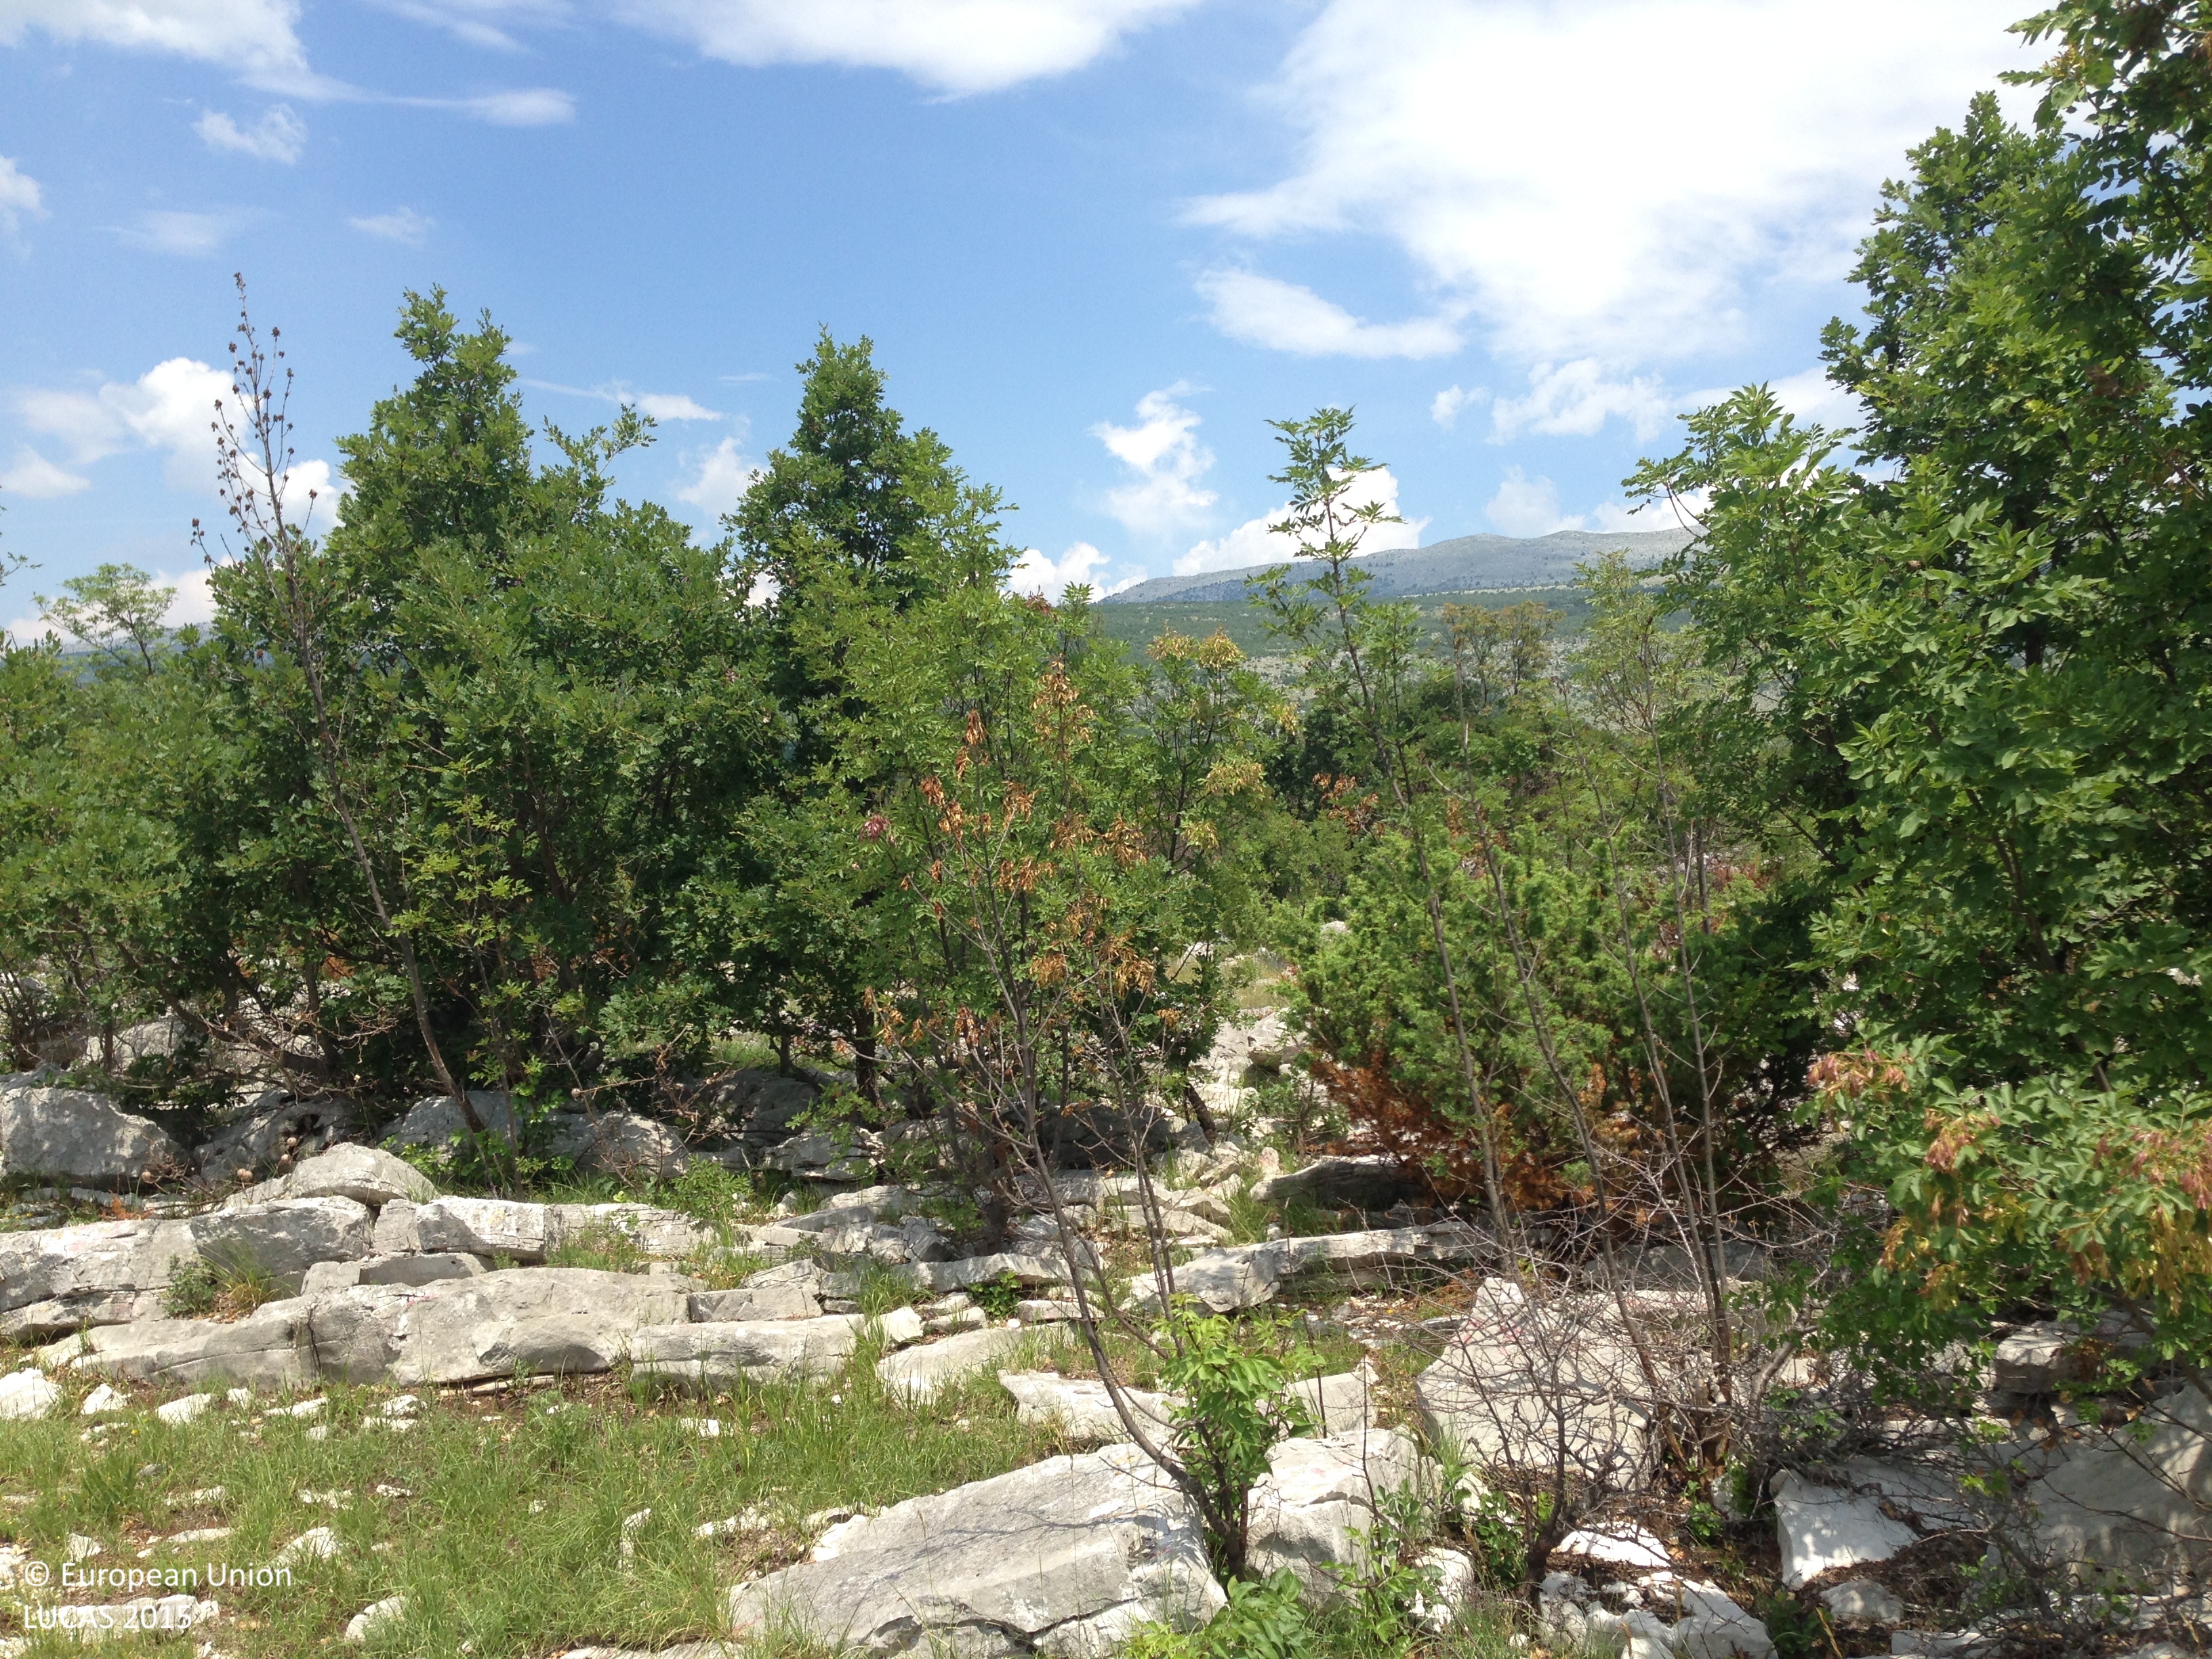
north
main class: Woodland
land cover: Broadleaved woodland
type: thermophilous deciduous forest
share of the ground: 25 - 50 %
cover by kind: broadleaved forest trees 45 %, unconsolidated bare surface 30 %, herbaceous plants 15 %, shrubs 10 %
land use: Semi-natural and natural areas not in use
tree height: < 5 m
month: June
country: HR
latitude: 43.7526
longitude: 16.4374
